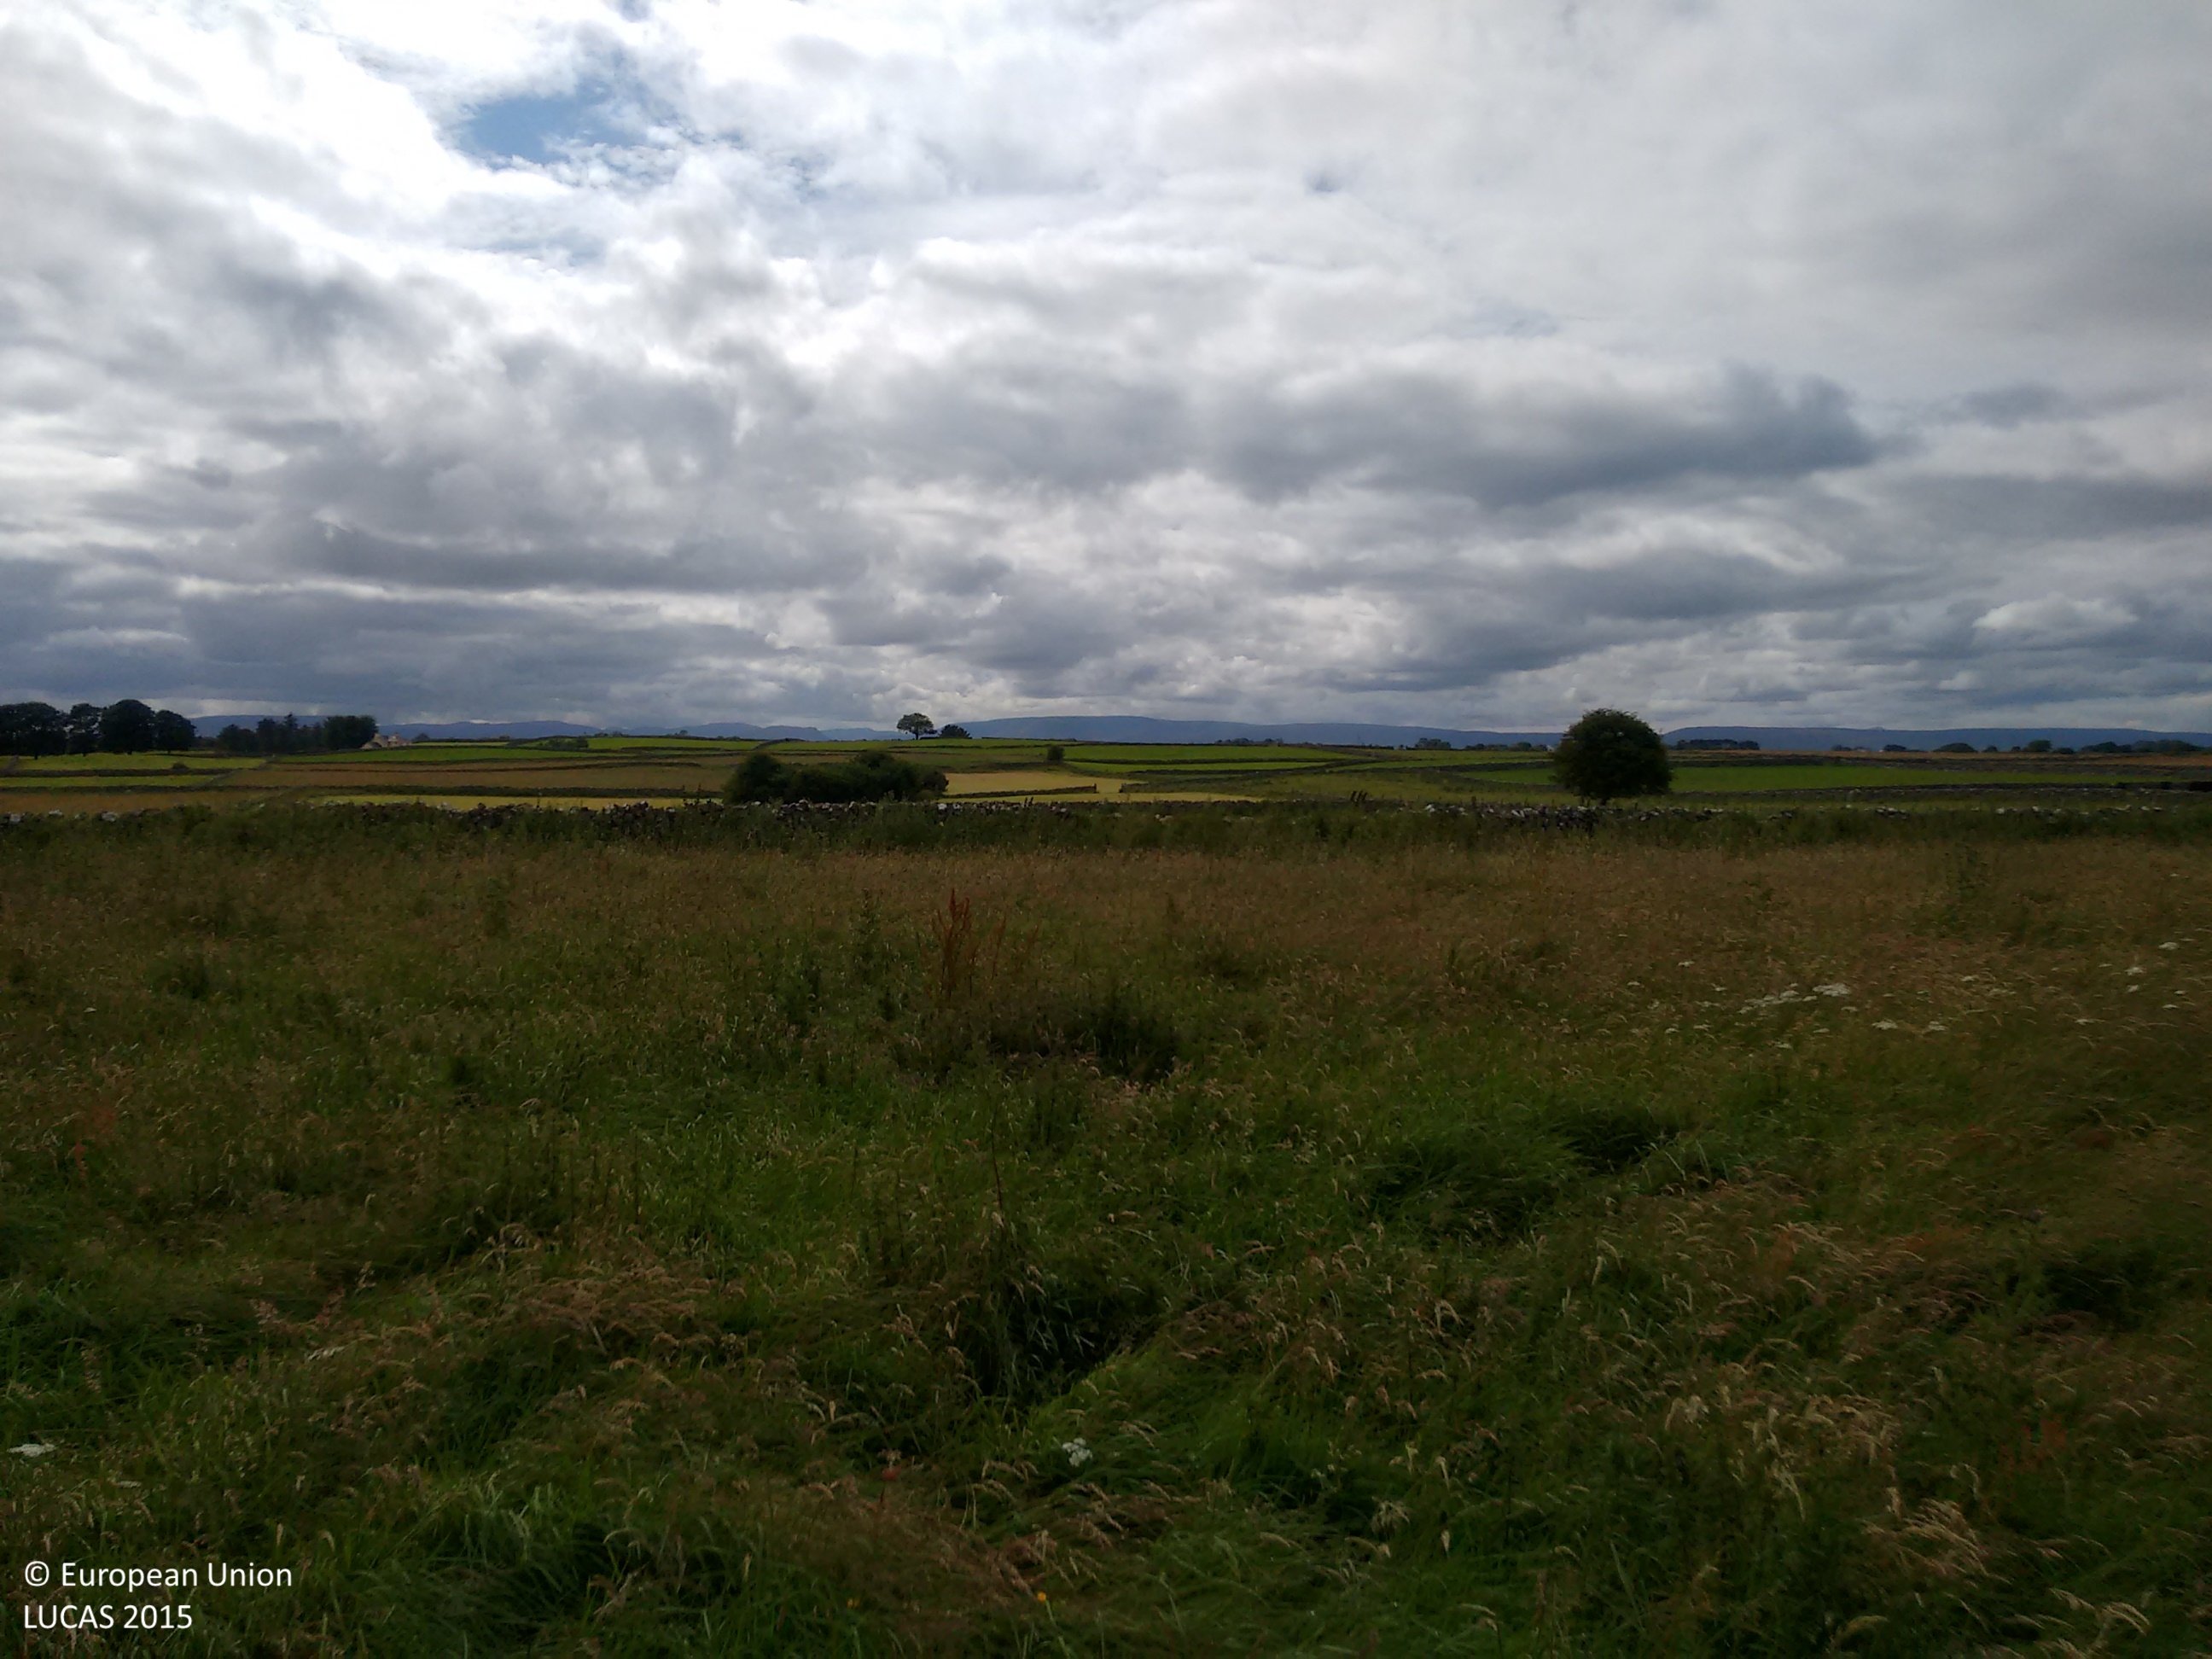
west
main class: Grassland
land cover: Grassland without tree/shrub cover
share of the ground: > 75 %
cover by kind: herbaceous plants 100 %
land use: Agriculture (excluding fallow land and kitchen gardens)
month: July
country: IE
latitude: 53.6146
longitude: -9.1277
